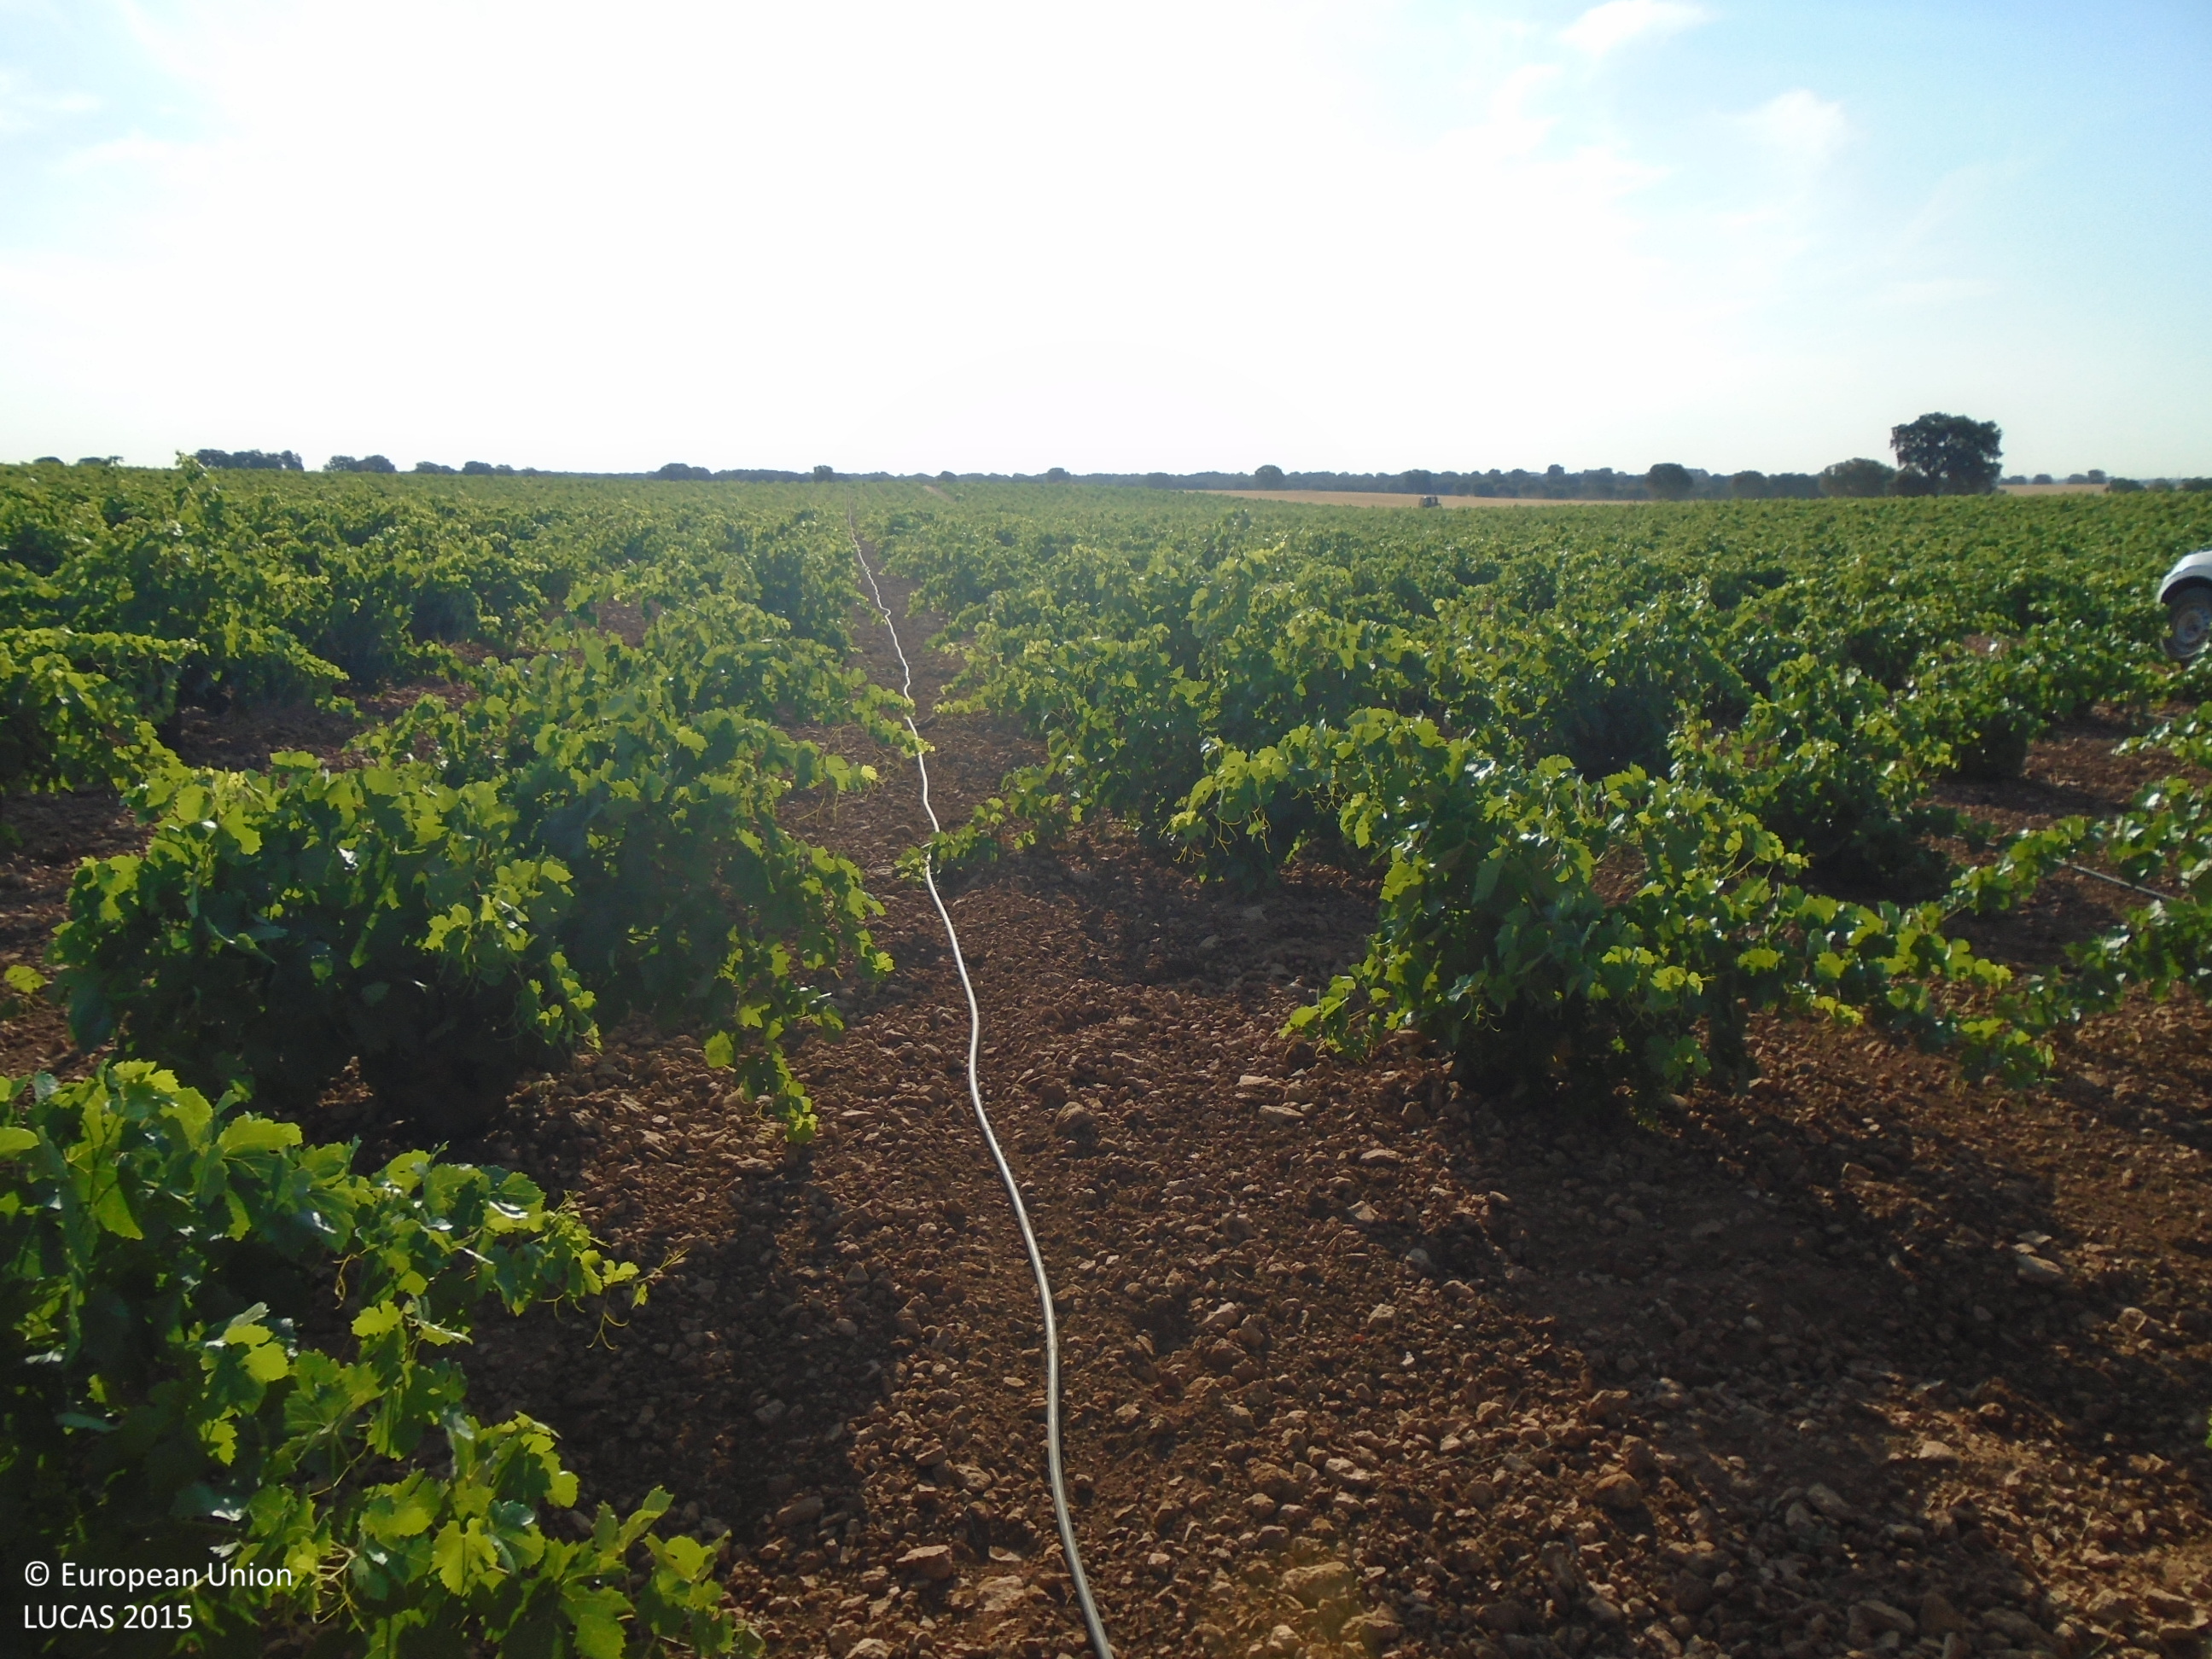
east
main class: Cropland
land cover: Vineyards
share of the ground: 25 - 50 %
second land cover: Other bare soil
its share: > 75 %
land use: Agriculture (excluding fallow land and kitchen gardens)
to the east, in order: Vineyards; Other bare soil; Tracks; Grass margins; Vineyards
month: June
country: ES
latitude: 39.2599
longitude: -3.4741
